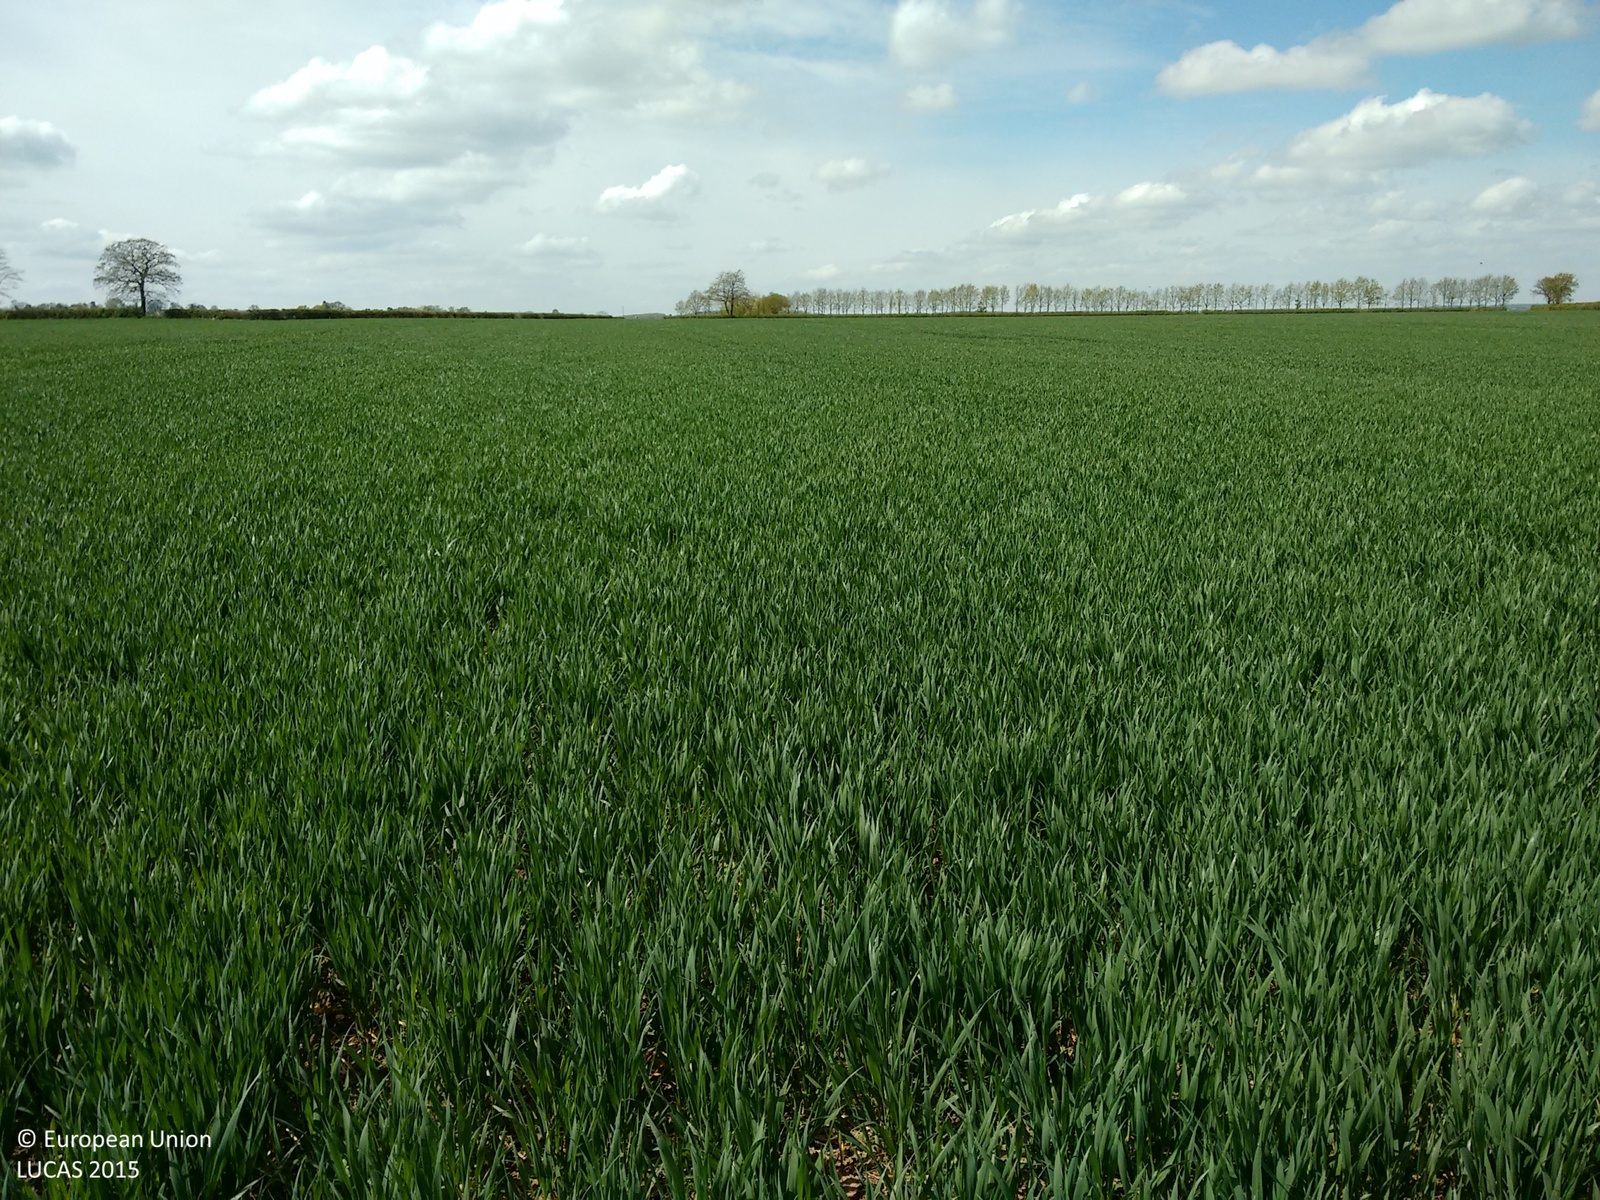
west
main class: Cropland
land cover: Common wheat
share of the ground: > 75 %
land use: Agriculture (excluding fallow land and kitchen gardens)
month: May
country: GB
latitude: 52.0068
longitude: -0.8373
